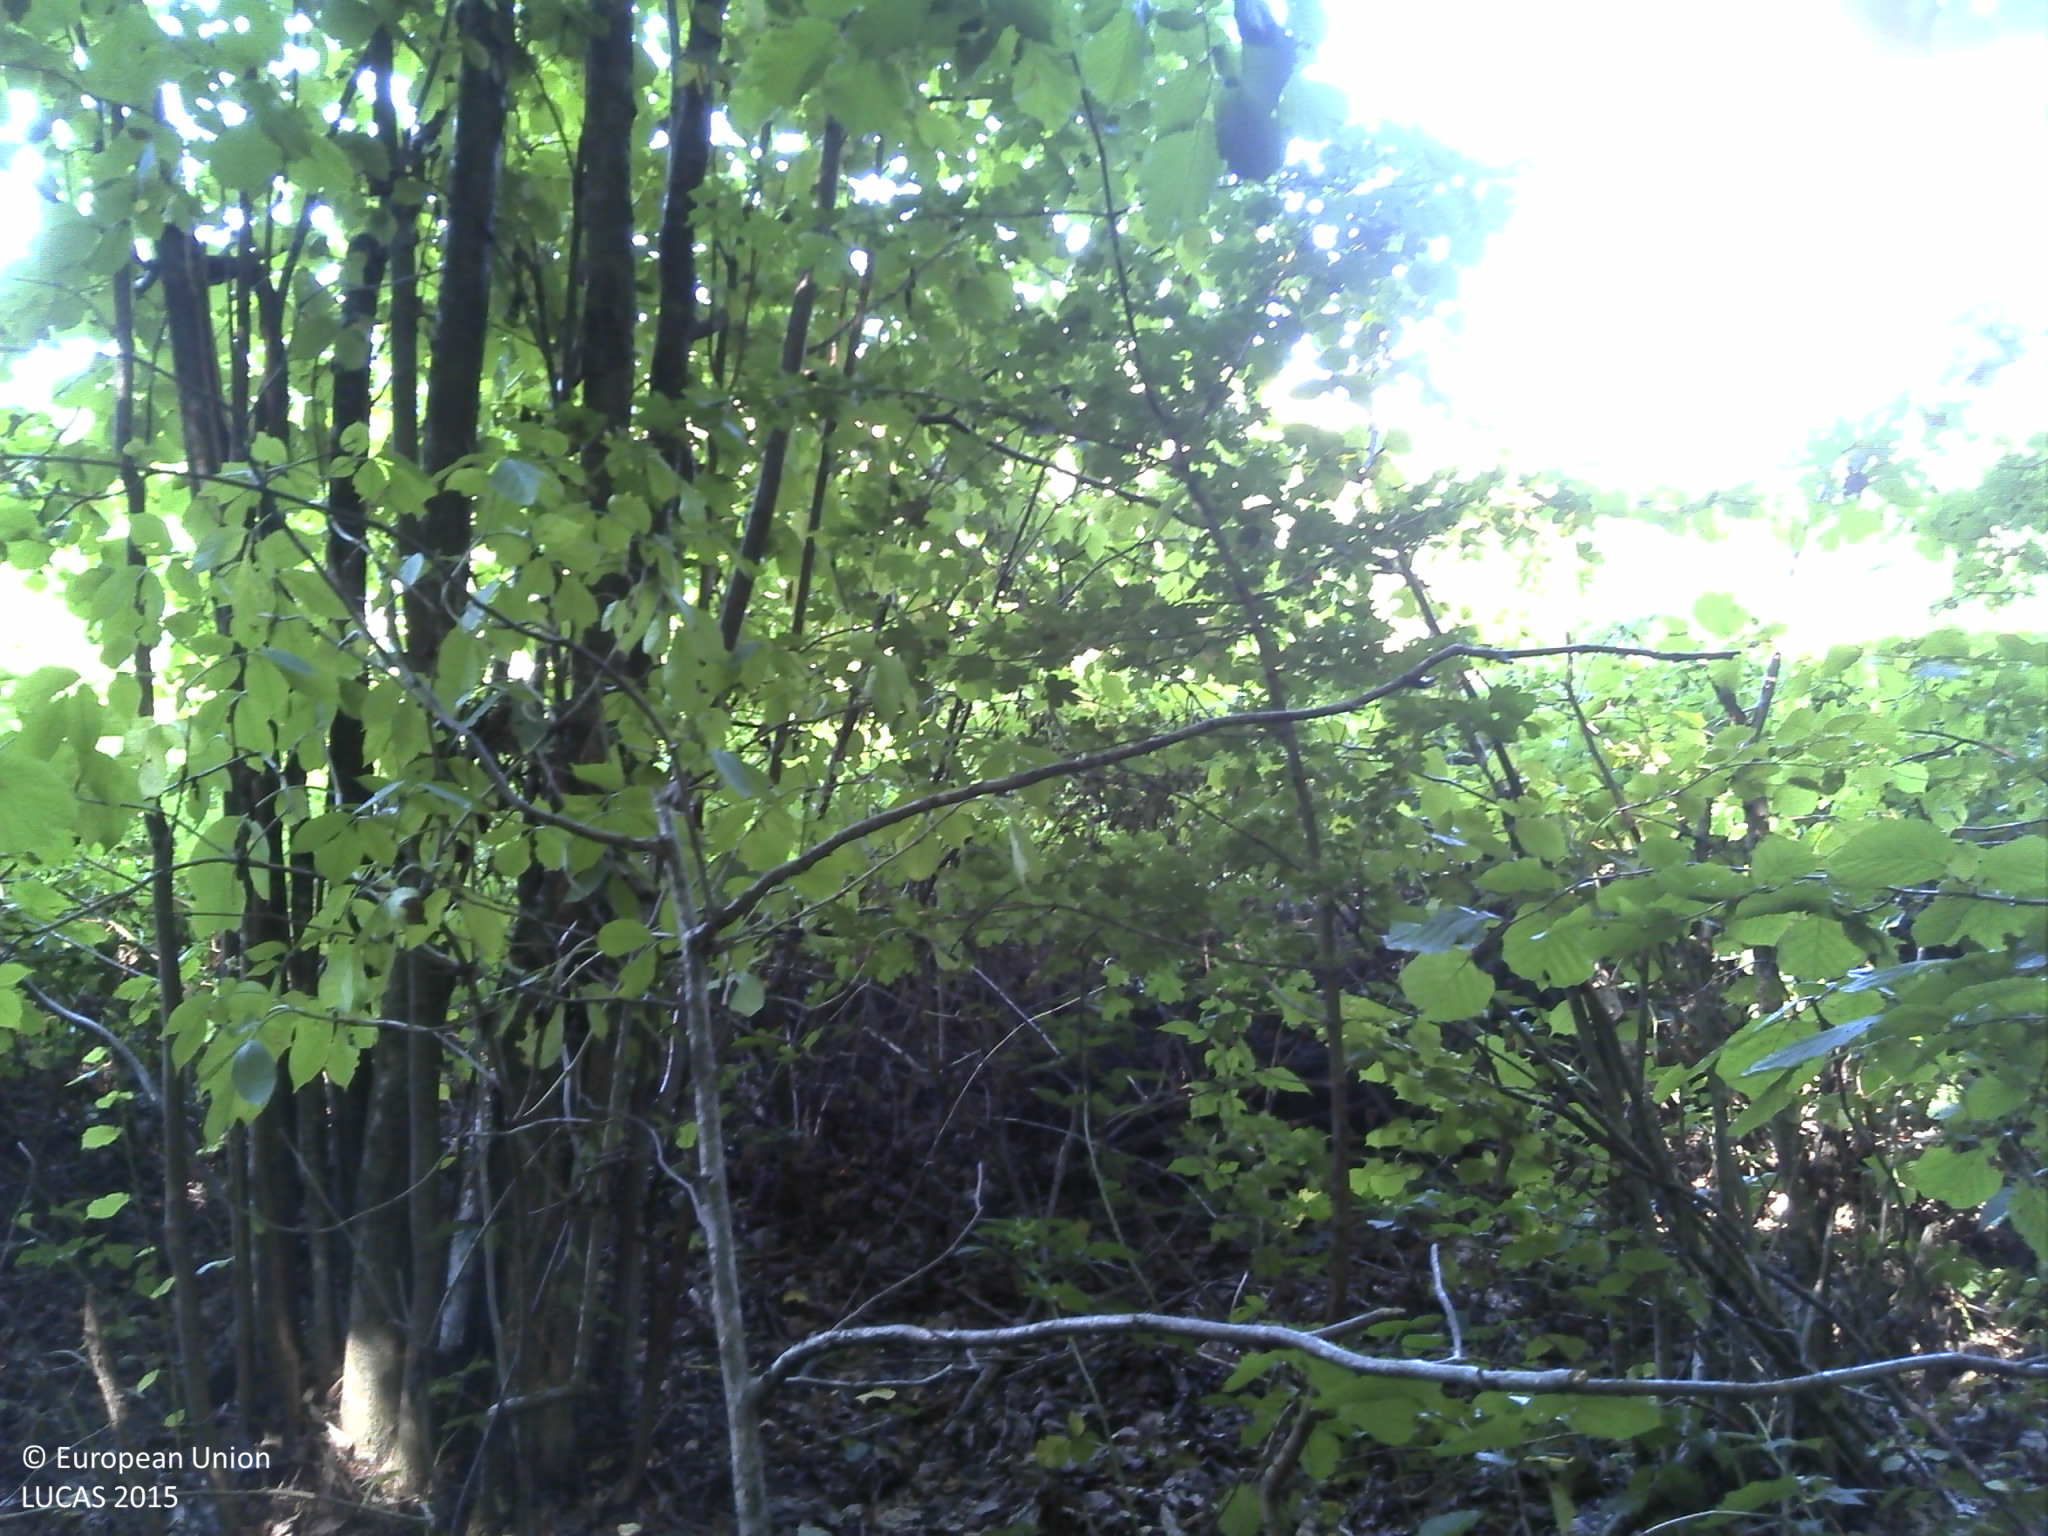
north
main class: Woodland
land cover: Broadleaved woodland
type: mesophytic deciduous forest
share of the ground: > 75 %
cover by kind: broadleaved forest trees 100 %
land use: Forestry
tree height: > 5 m
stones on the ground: < 10 %
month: August
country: HR
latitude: 45.7616
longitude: 16.6982
